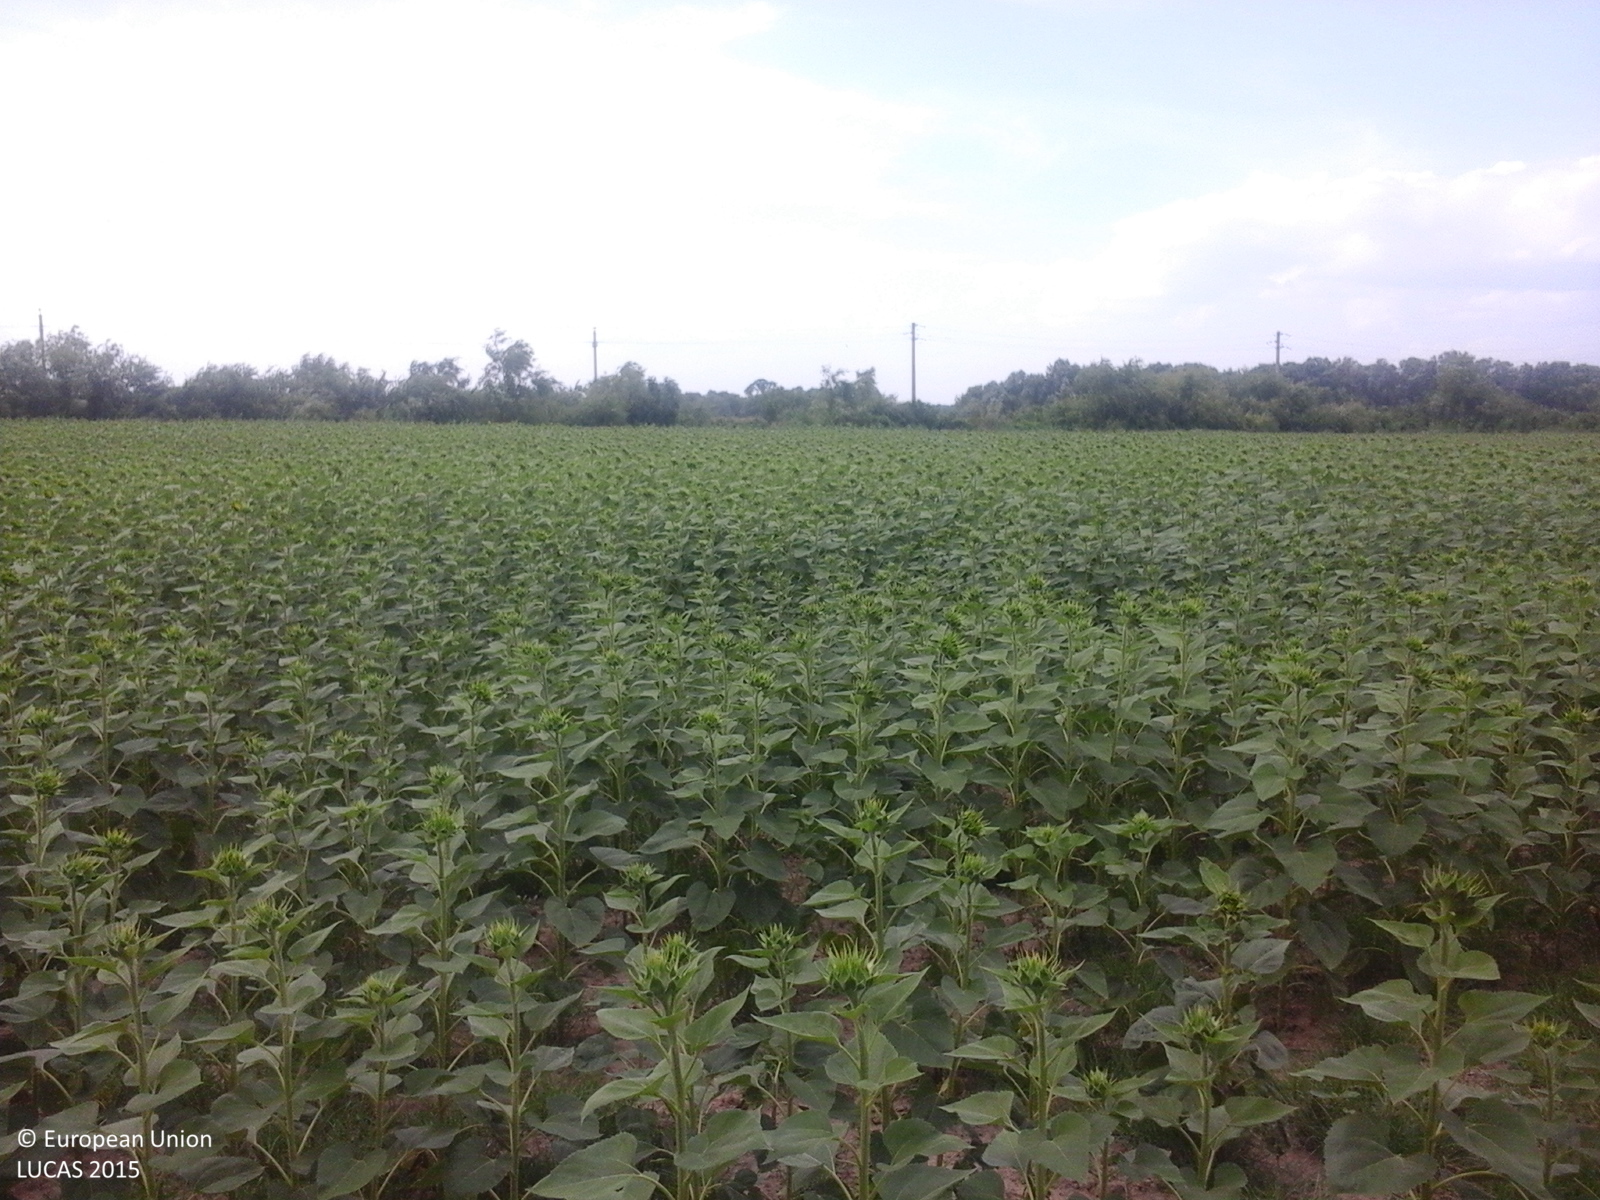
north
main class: Cropland
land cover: Sunflower
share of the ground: > 75 %
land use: Agriculture (excluding fallow land and kitchen gardens)
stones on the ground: < 10 %
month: June
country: RO
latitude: 44.2292
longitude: 25.9358
